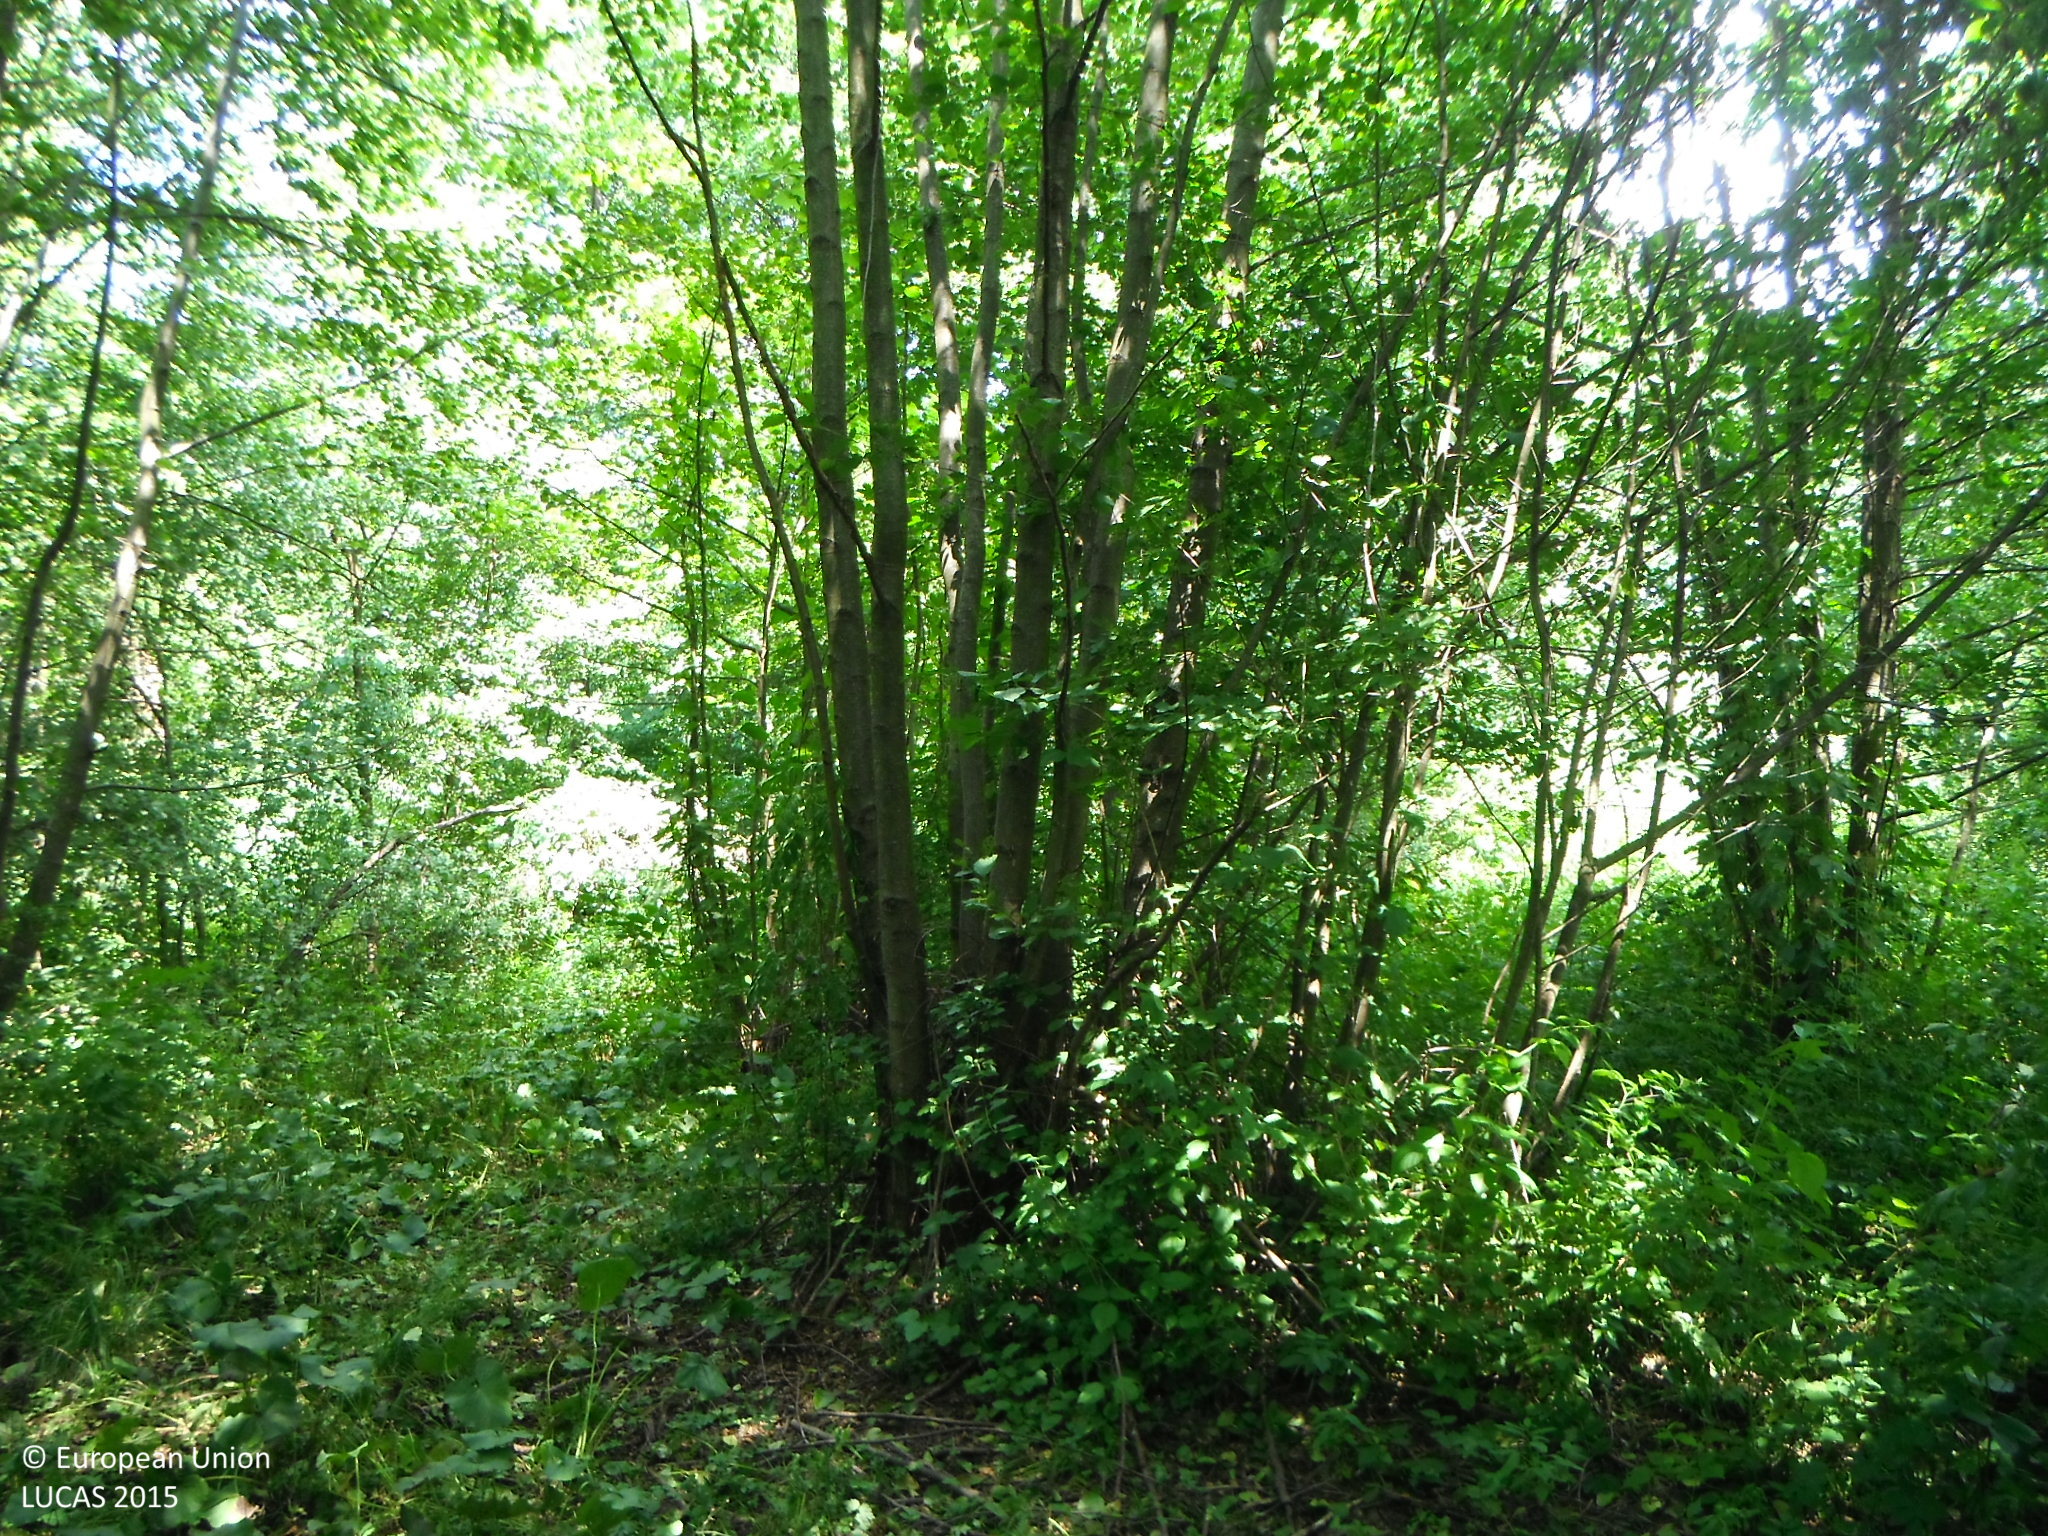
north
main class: Woodland
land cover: Broadleaved woodland
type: mesophytic deciduous forest
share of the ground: > 75 %
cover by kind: broadleaved forest trees 100 %
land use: Semi-natural and natural areas not in use
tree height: > 5 m
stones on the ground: < 10 %
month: July
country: SK
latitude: 48.7167
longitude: 20.1301
